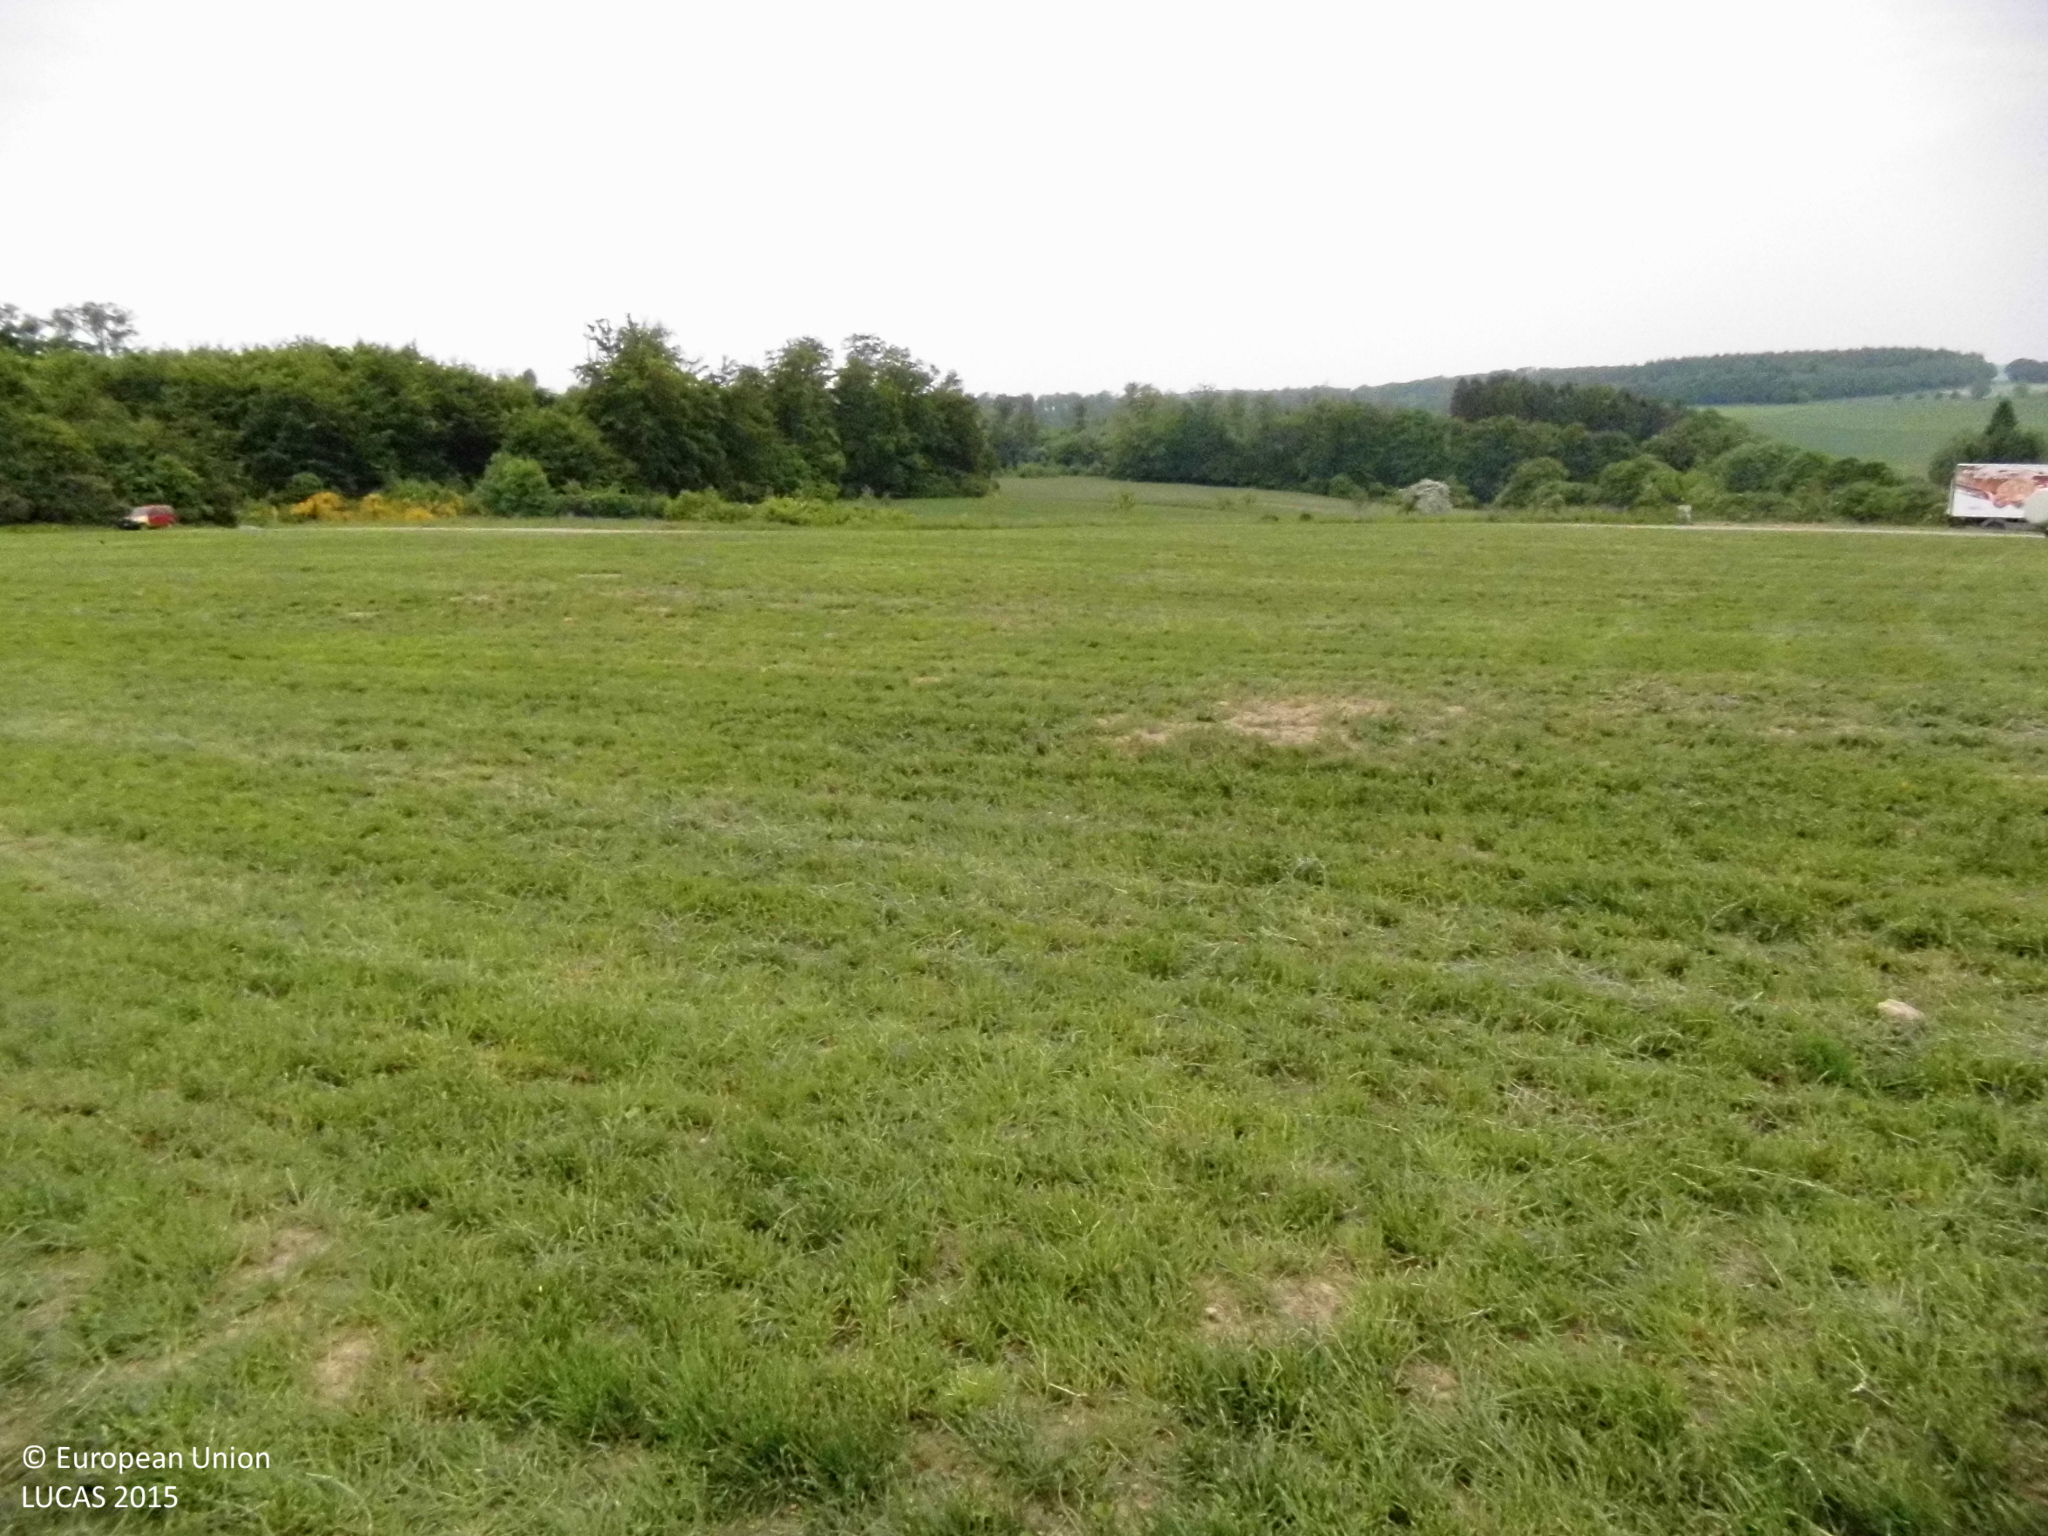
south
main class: Grassland
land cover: Grassland without tree/shrub cover
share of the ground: > 75 %
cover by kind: herbaceous plants 100 %
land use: Agriculture (excluding fallow land and kitchen gardens)
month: May
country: DE
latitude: 50.5341
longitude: 7.4748
